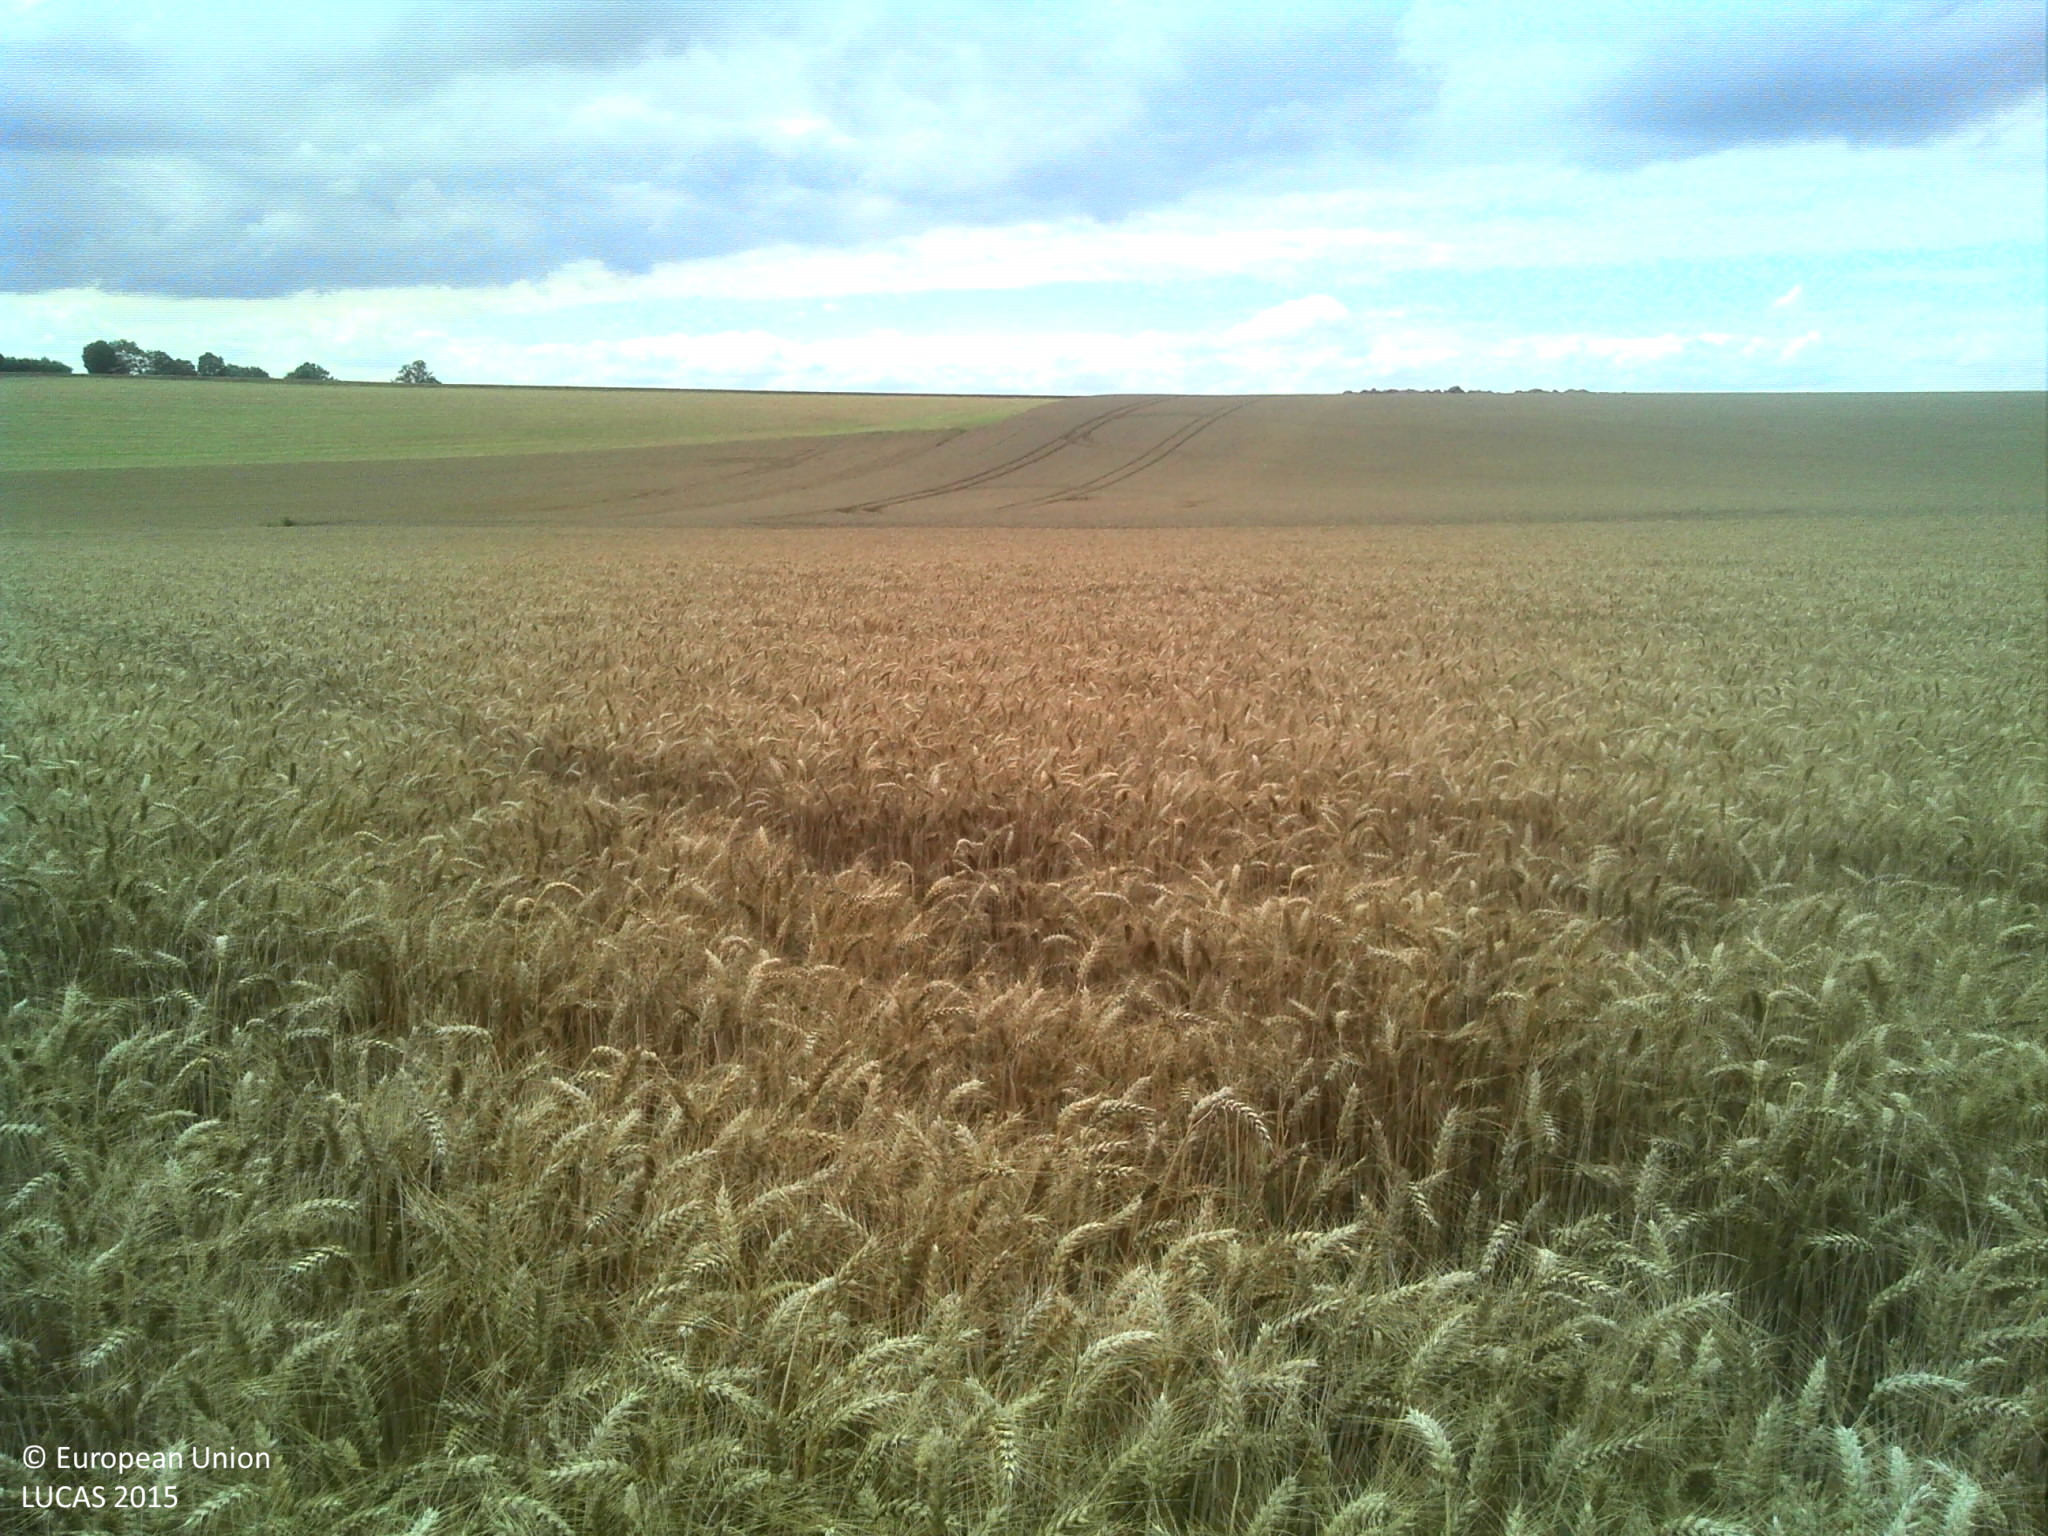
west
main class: Cropland
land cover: Common wheat
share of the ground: > 75 %
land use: Agriculture (excluding fallow land and kitchen gardens)
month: July
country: FR
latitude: 49.8263
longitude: 3.6404
